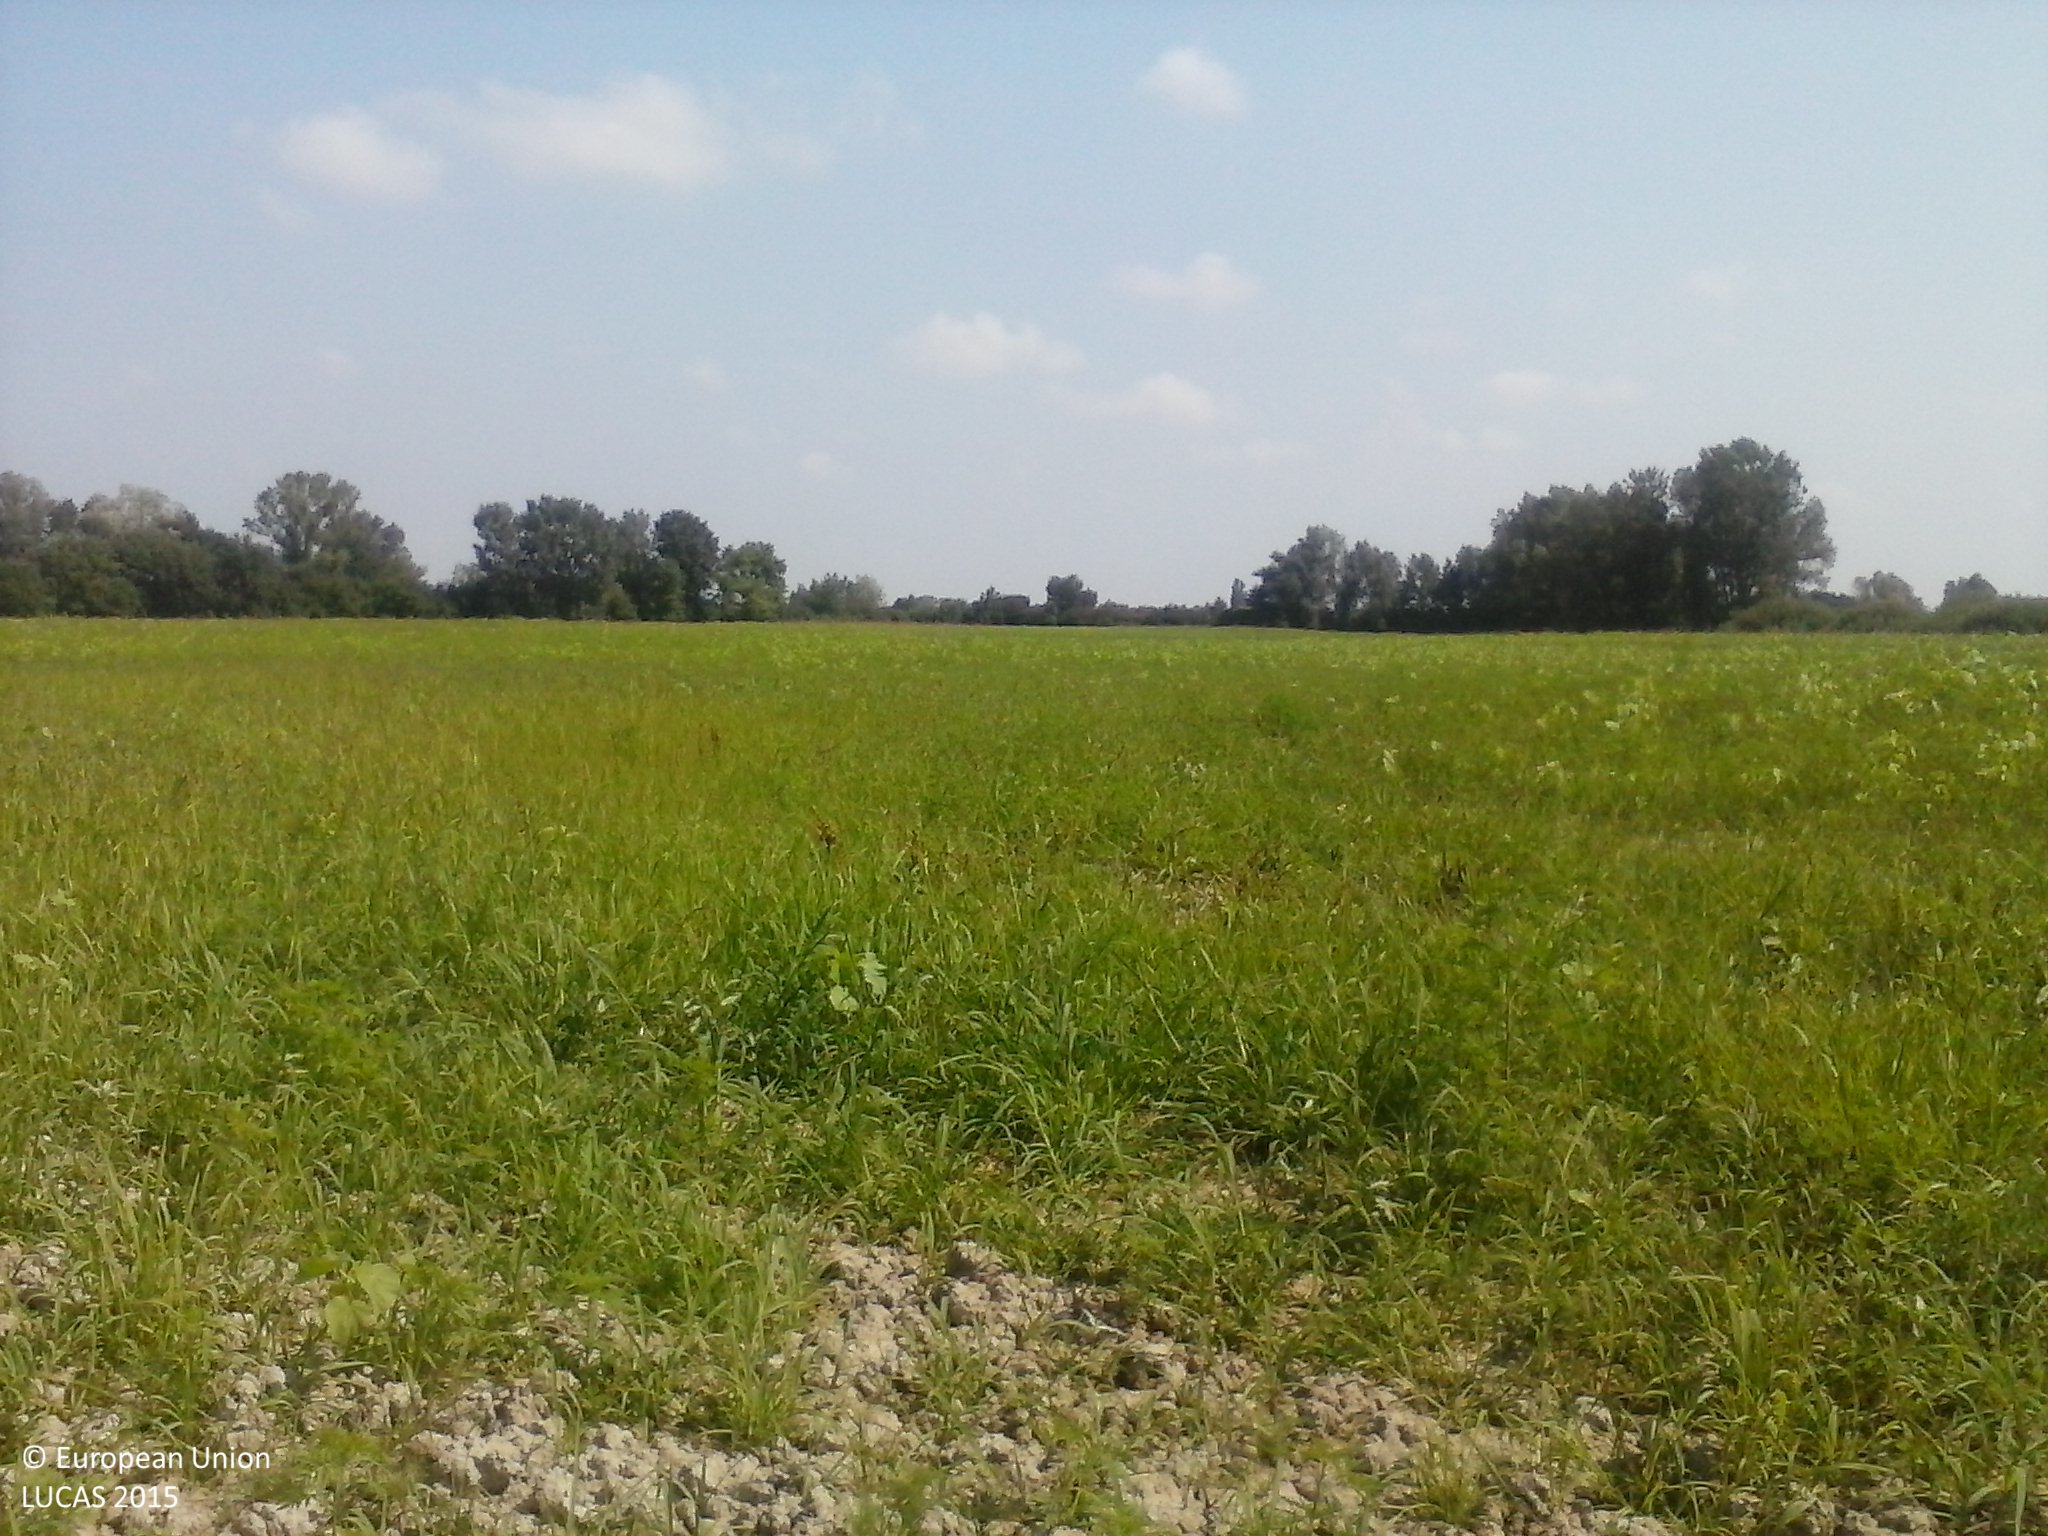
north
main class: Grassland
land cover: Spontaneously vegetated surfaces
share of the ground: > 75 %
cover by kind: herbaceous plants 80 %, unconsolidated bare surface 20 %
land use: Fallow land
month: August
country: HU
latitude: 45.8673
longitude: 17.7976
